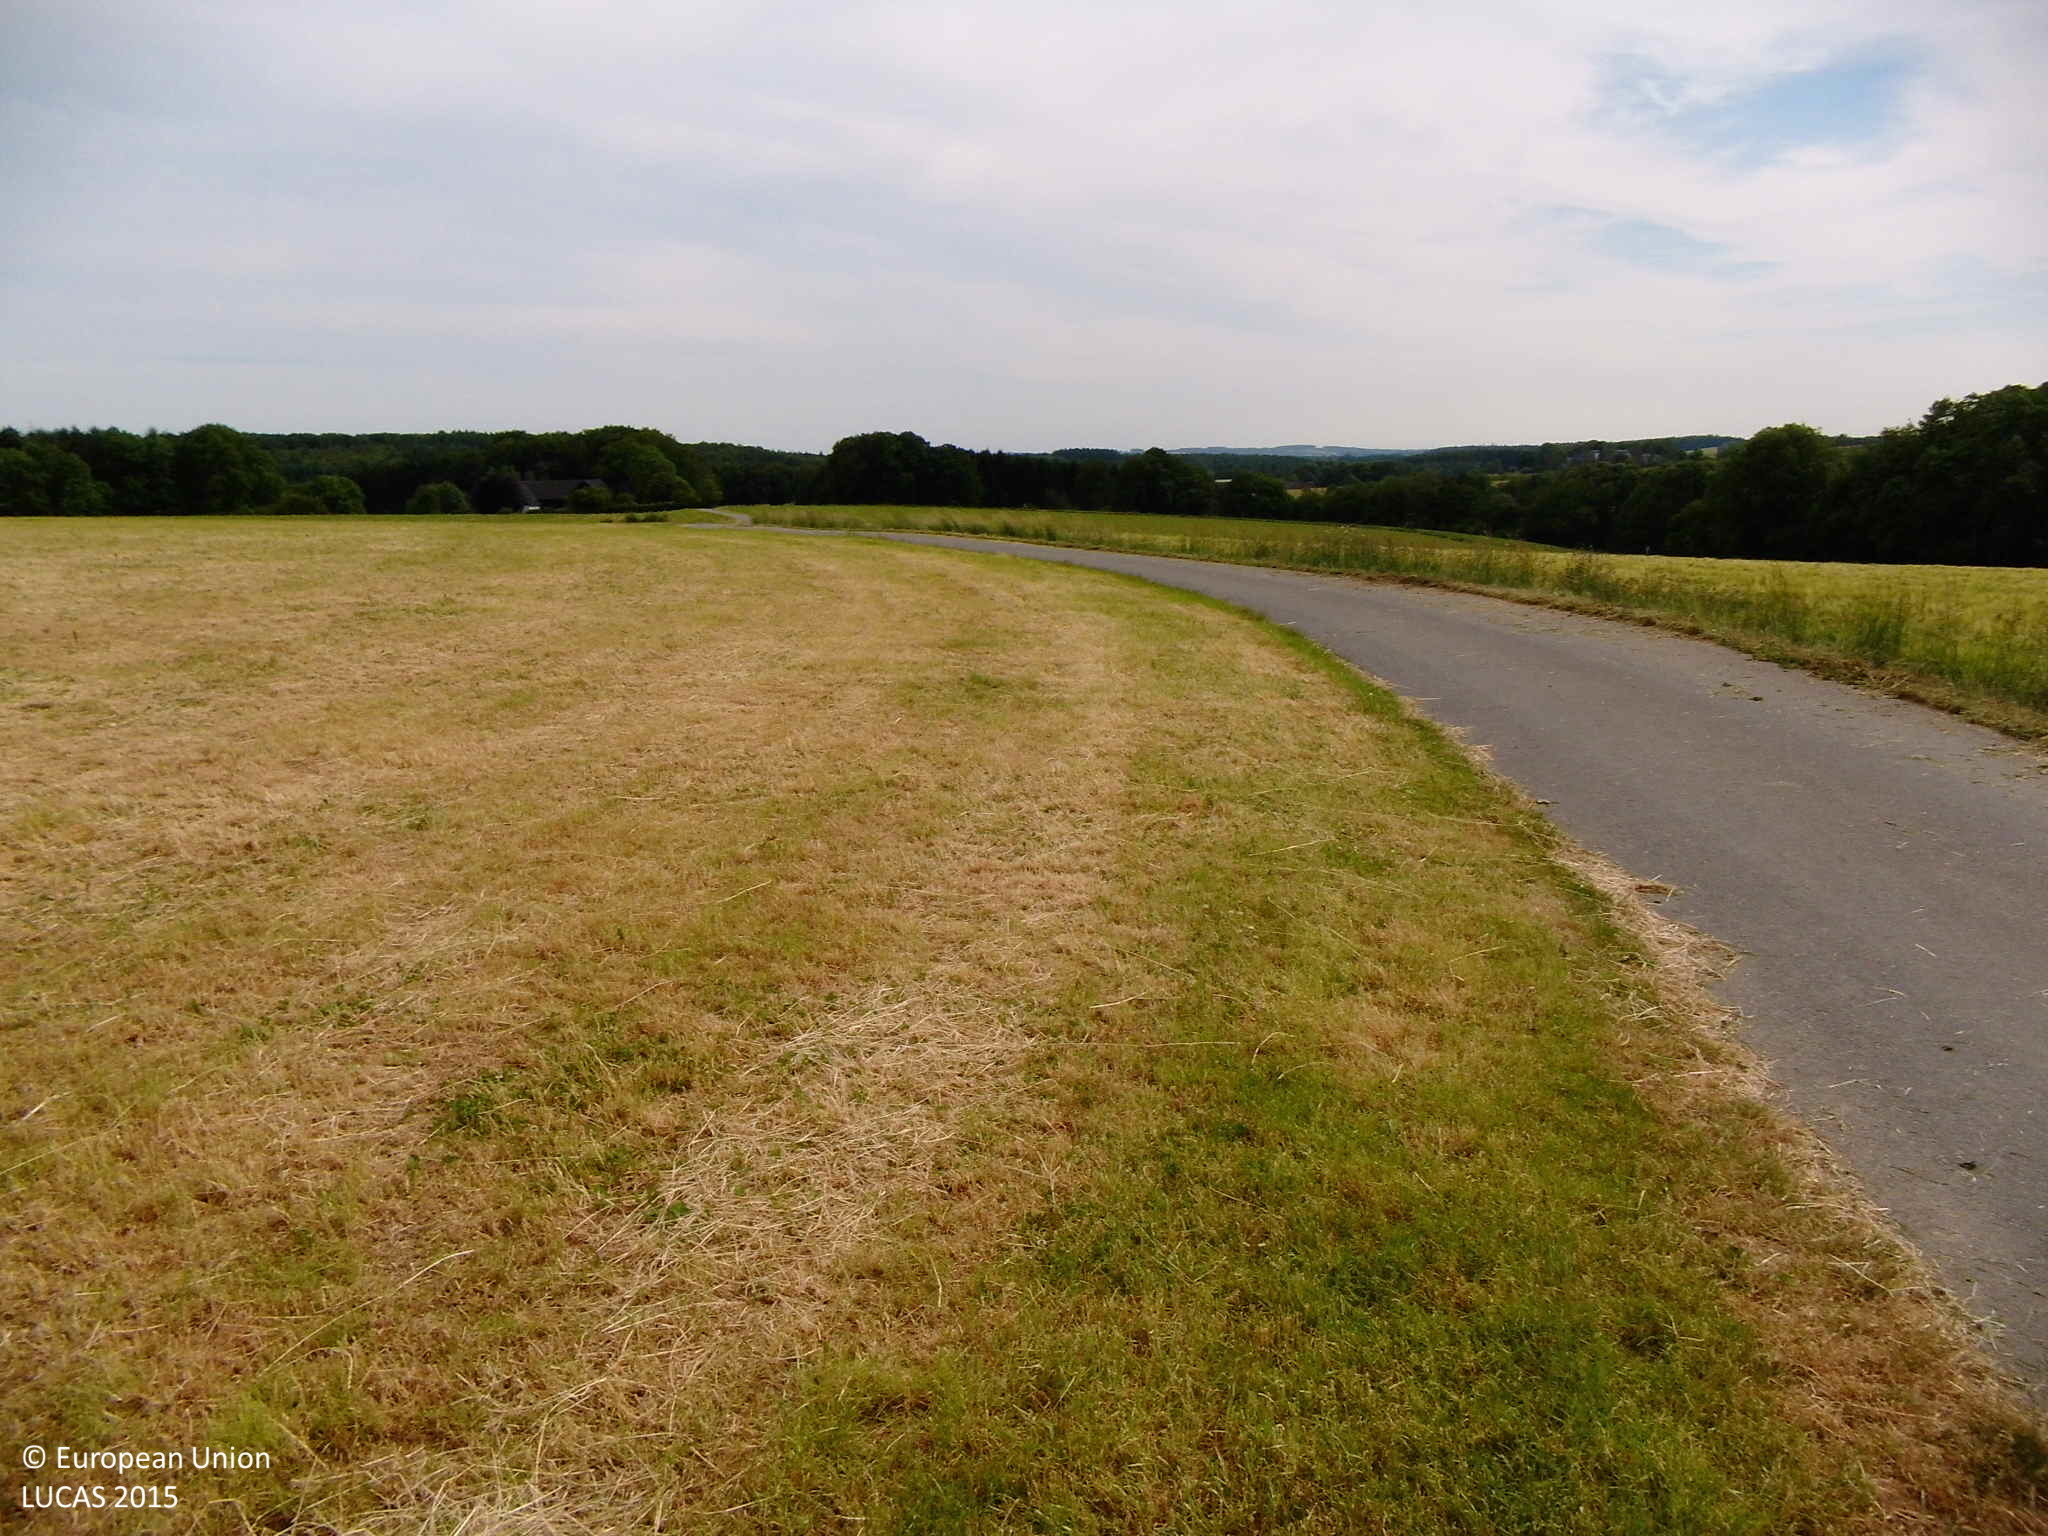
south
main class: Grassland
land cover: Grassland without tree/shrub cover
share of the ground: > 75 %
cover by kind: herbaceous plants 100 %
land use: Agriculture (excluding fallow land and kitchen gardens)
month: June
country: DE
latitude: 51.1809
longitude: 7.4395
